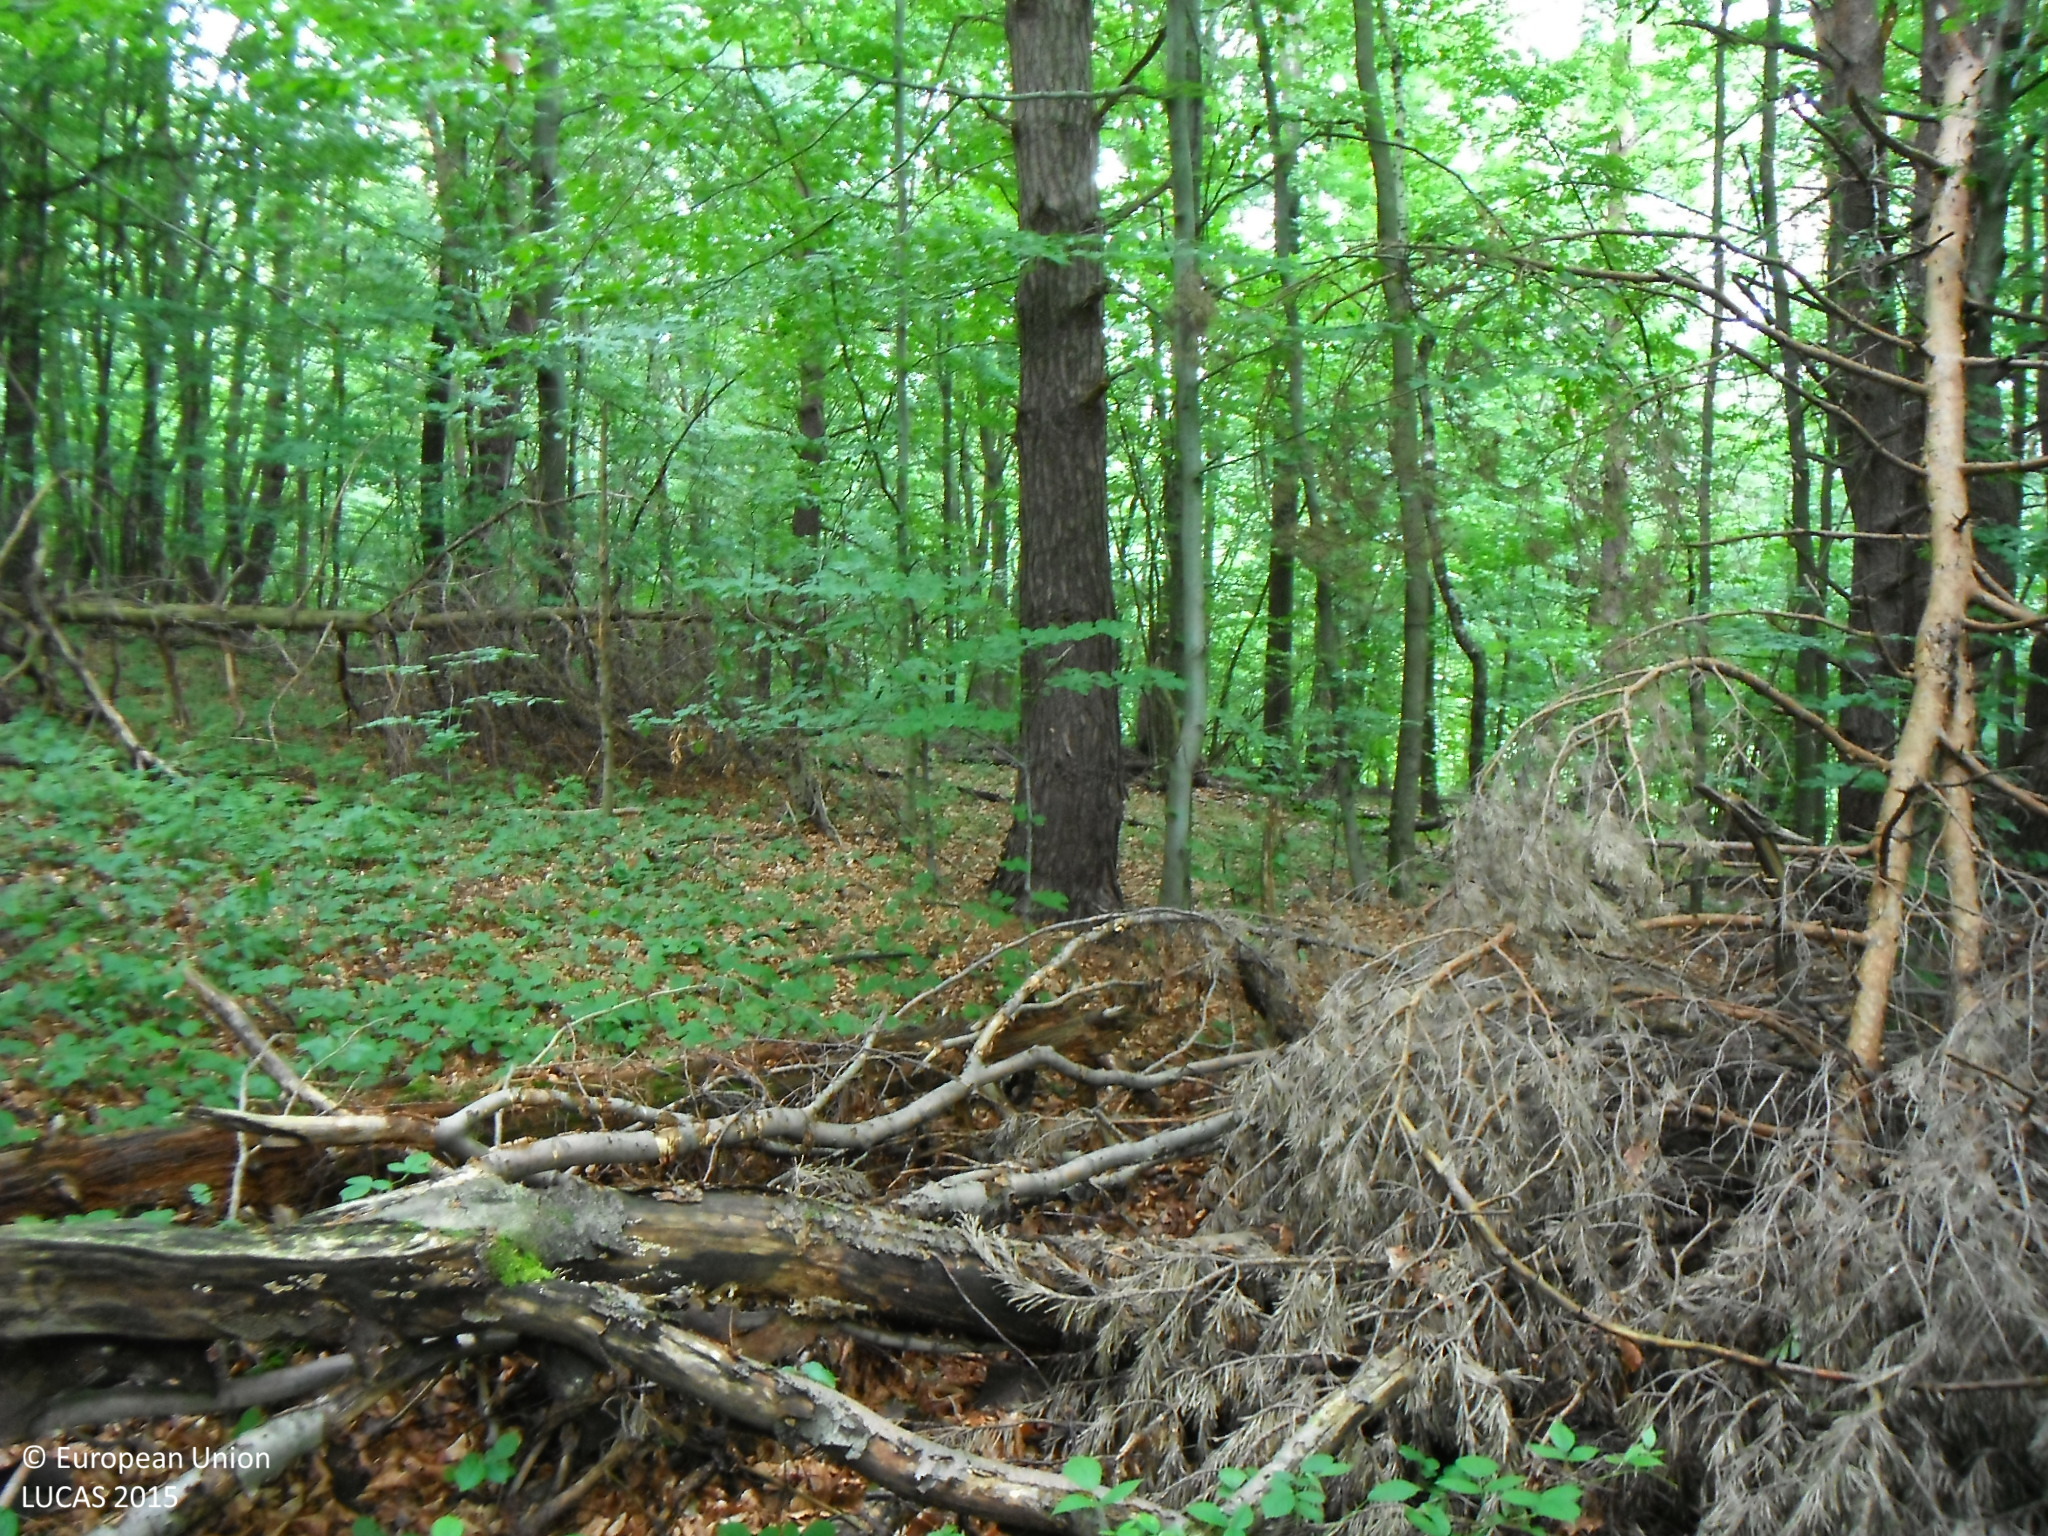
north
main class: Woodland
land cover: Pine dominated mixed woodland
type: hemiboreal forest and nemoral coniferous forest and mixed broadleaved-coniferous forest
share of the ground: > 75 %
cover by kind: coniferous forest trees 45 %, broadleaved forest trees 45 %, herbaceous plants 10 %
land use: Forestry
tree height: > 5 m
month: July
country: SK
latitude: 49.2866
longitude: 21.8917
